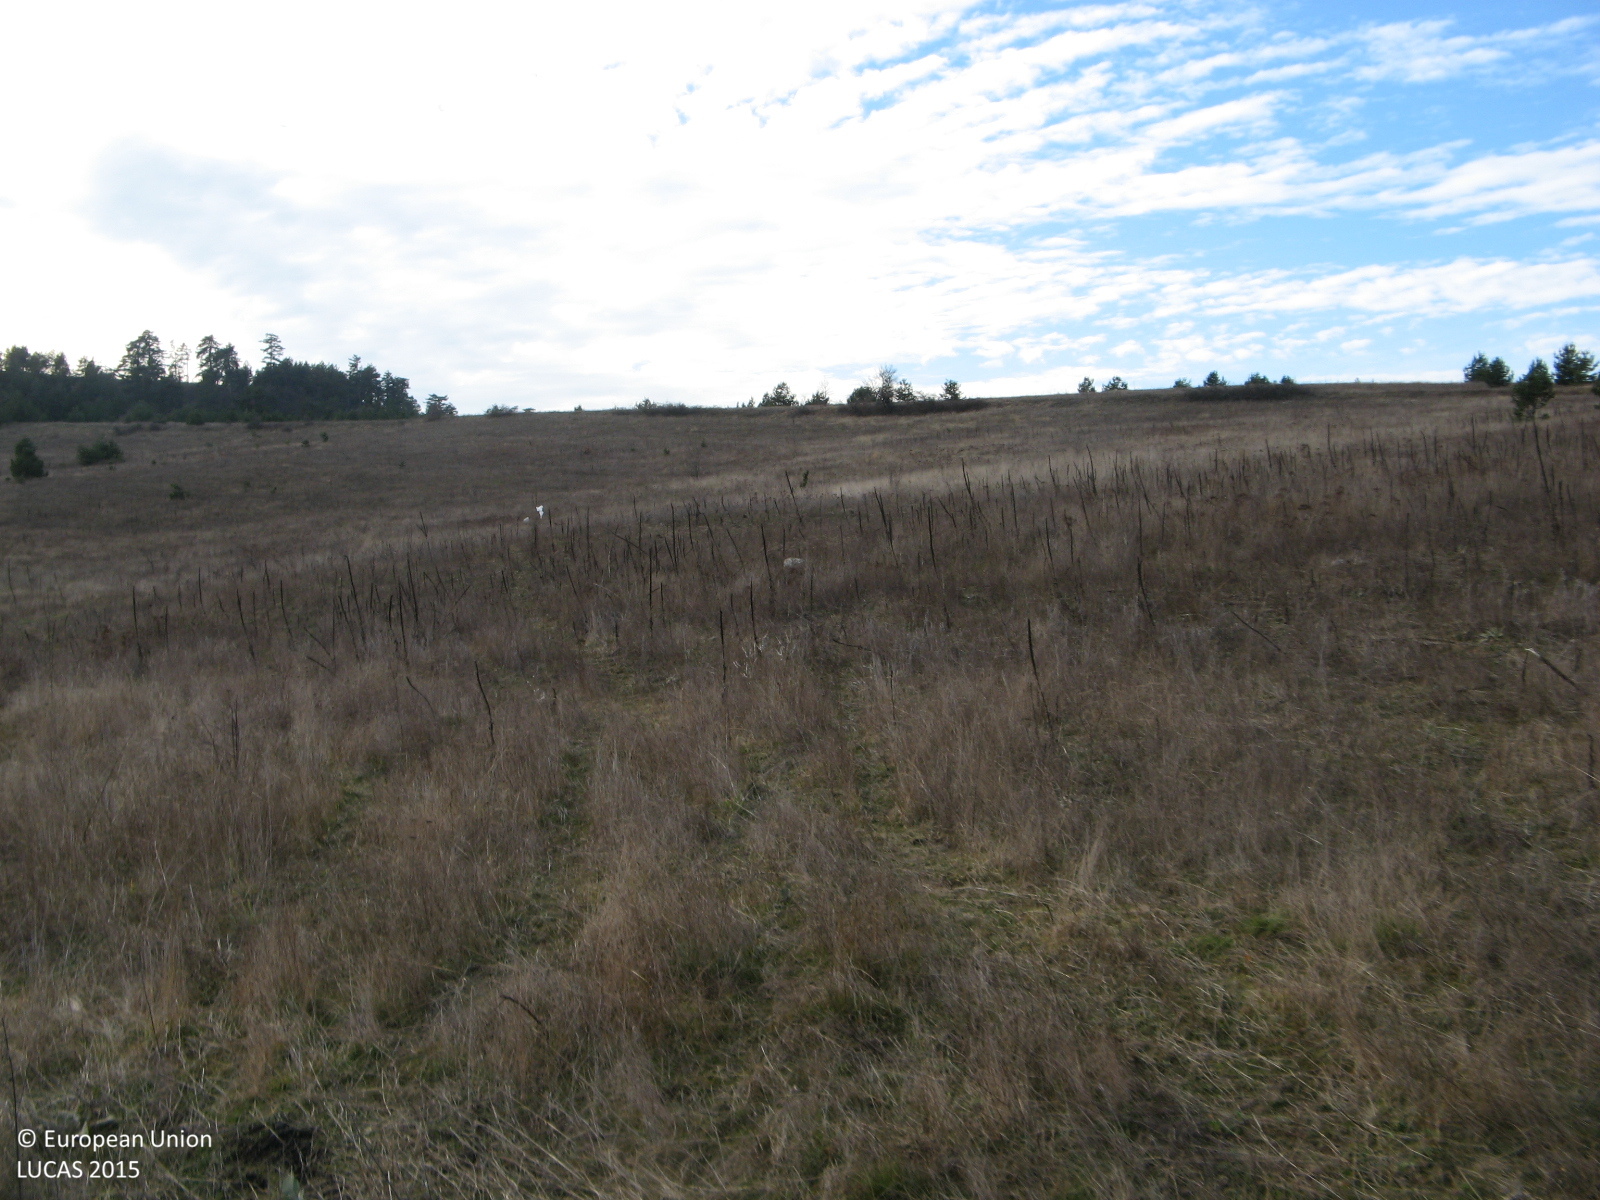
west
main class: Grassland
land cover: Grassland without tree/shrub cover
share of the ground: > 75 %
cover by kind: herbaceous plants 100 %
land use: Agriculture (excluding fallow land and kitchen gardens)
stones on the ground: < 10 %
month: December
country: BG
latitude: 42.0158
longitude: 24.0582
